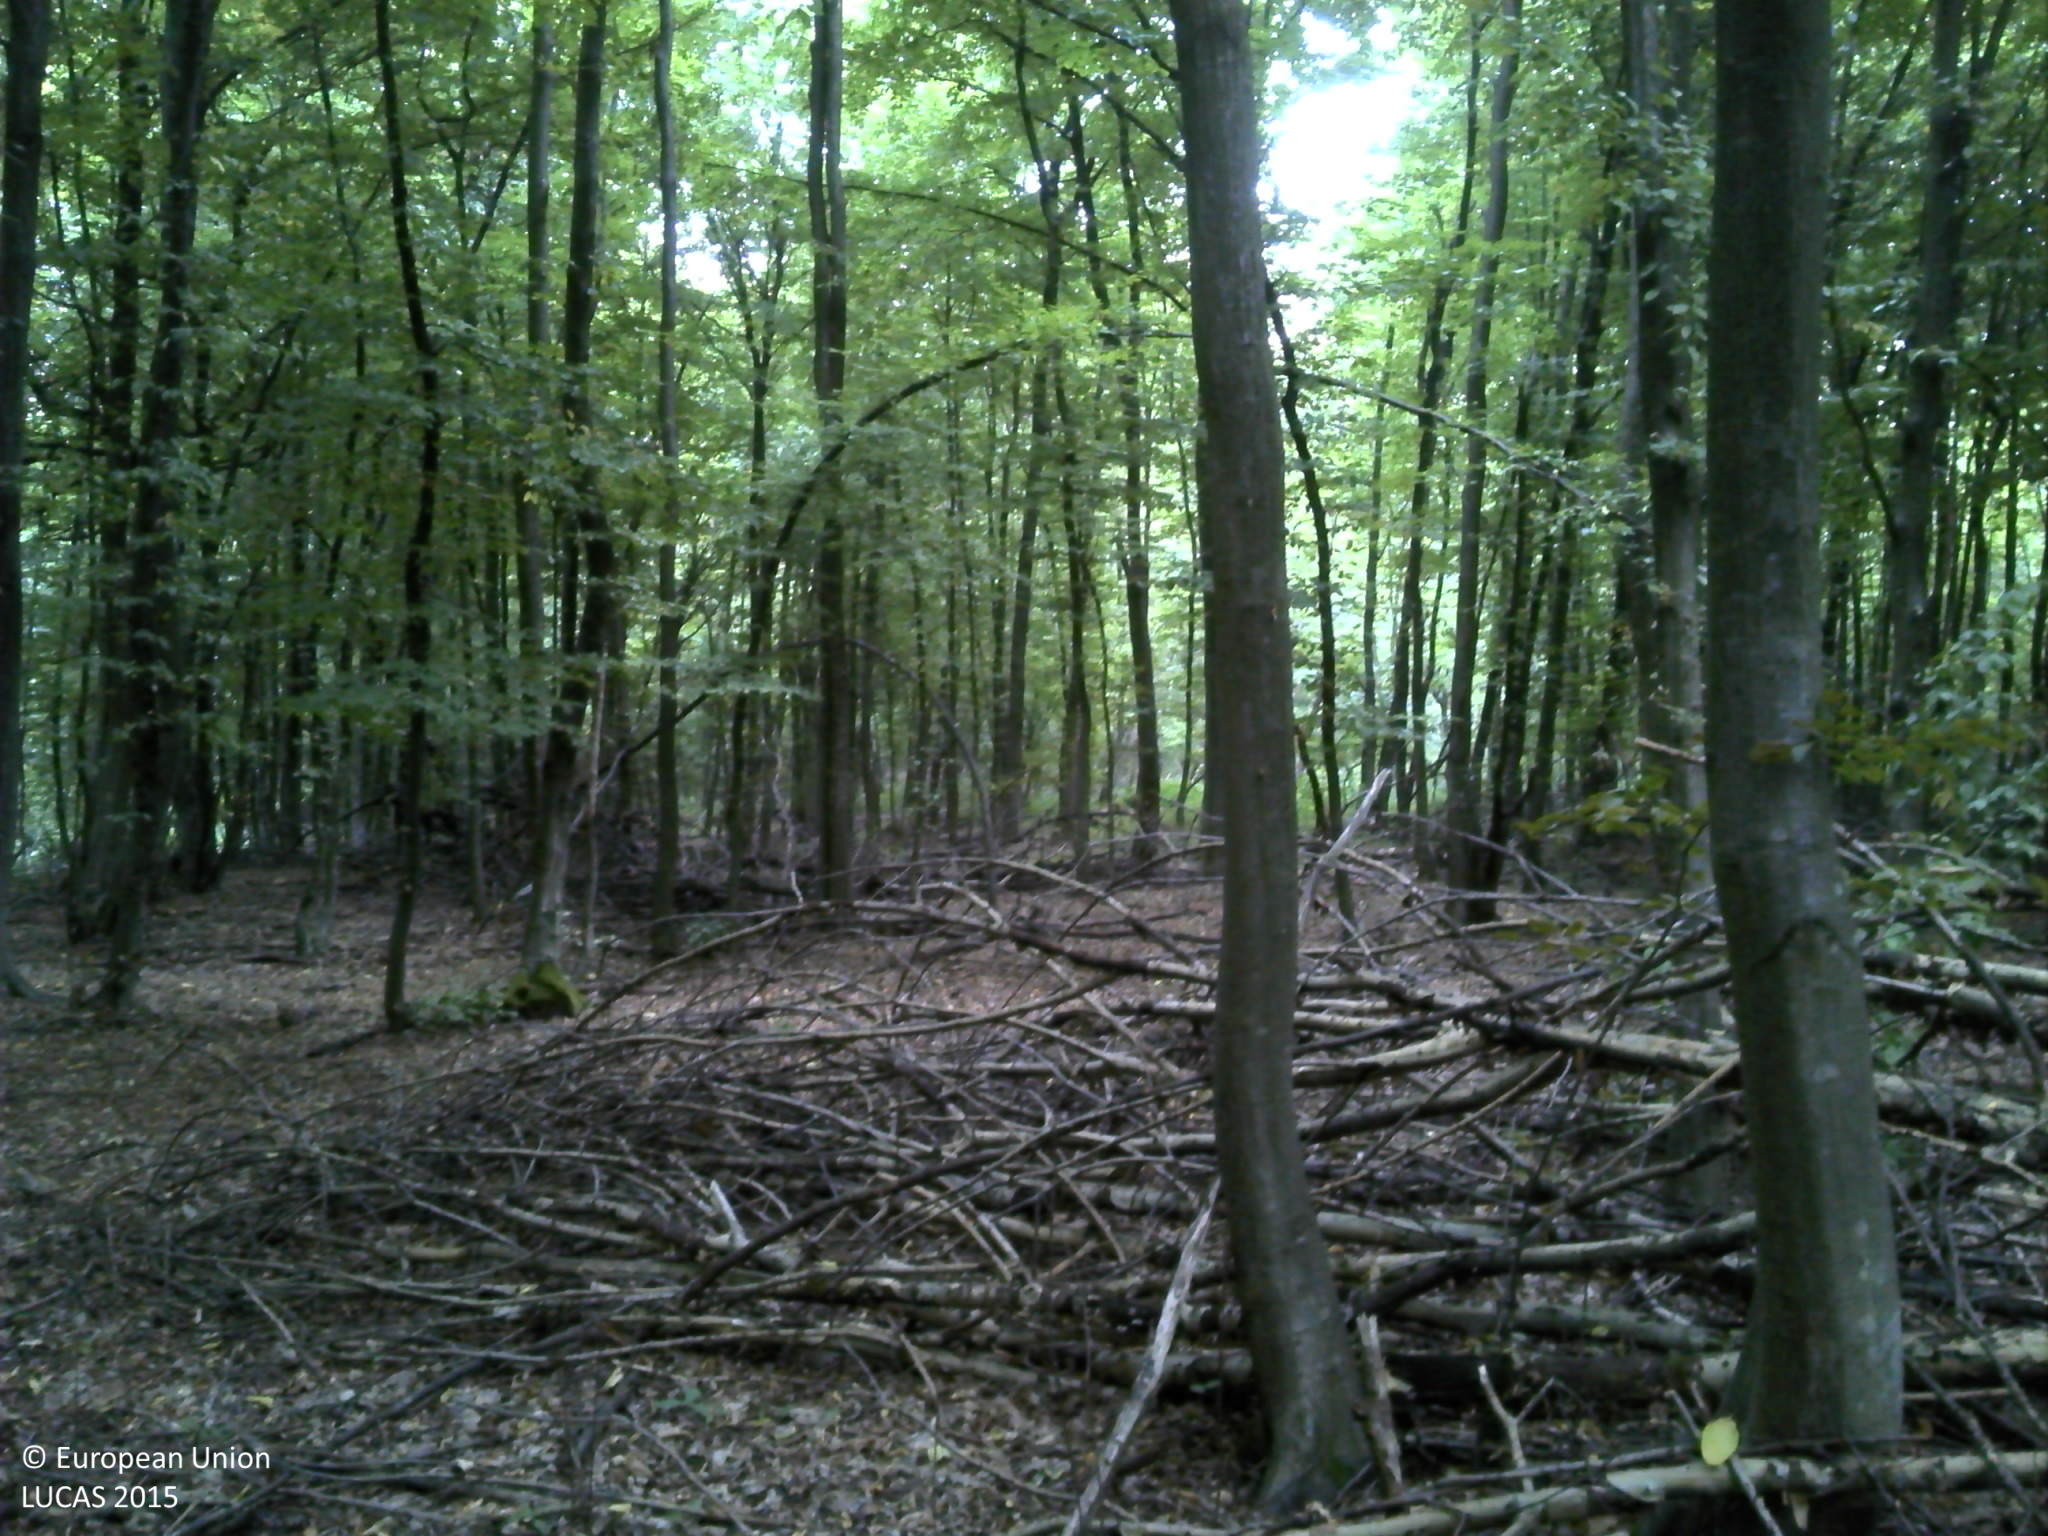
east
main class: Woodland
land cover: Broadleaved woodland
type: acidophilous oak and oak-birch forest
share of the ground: > 75 %
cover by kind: broadleaved forest trees 100 %
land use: Forestry
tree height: > 5 m
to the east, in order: Broadleaved woodland
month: August
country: HR
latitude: 45.4920
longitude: 17.9754
